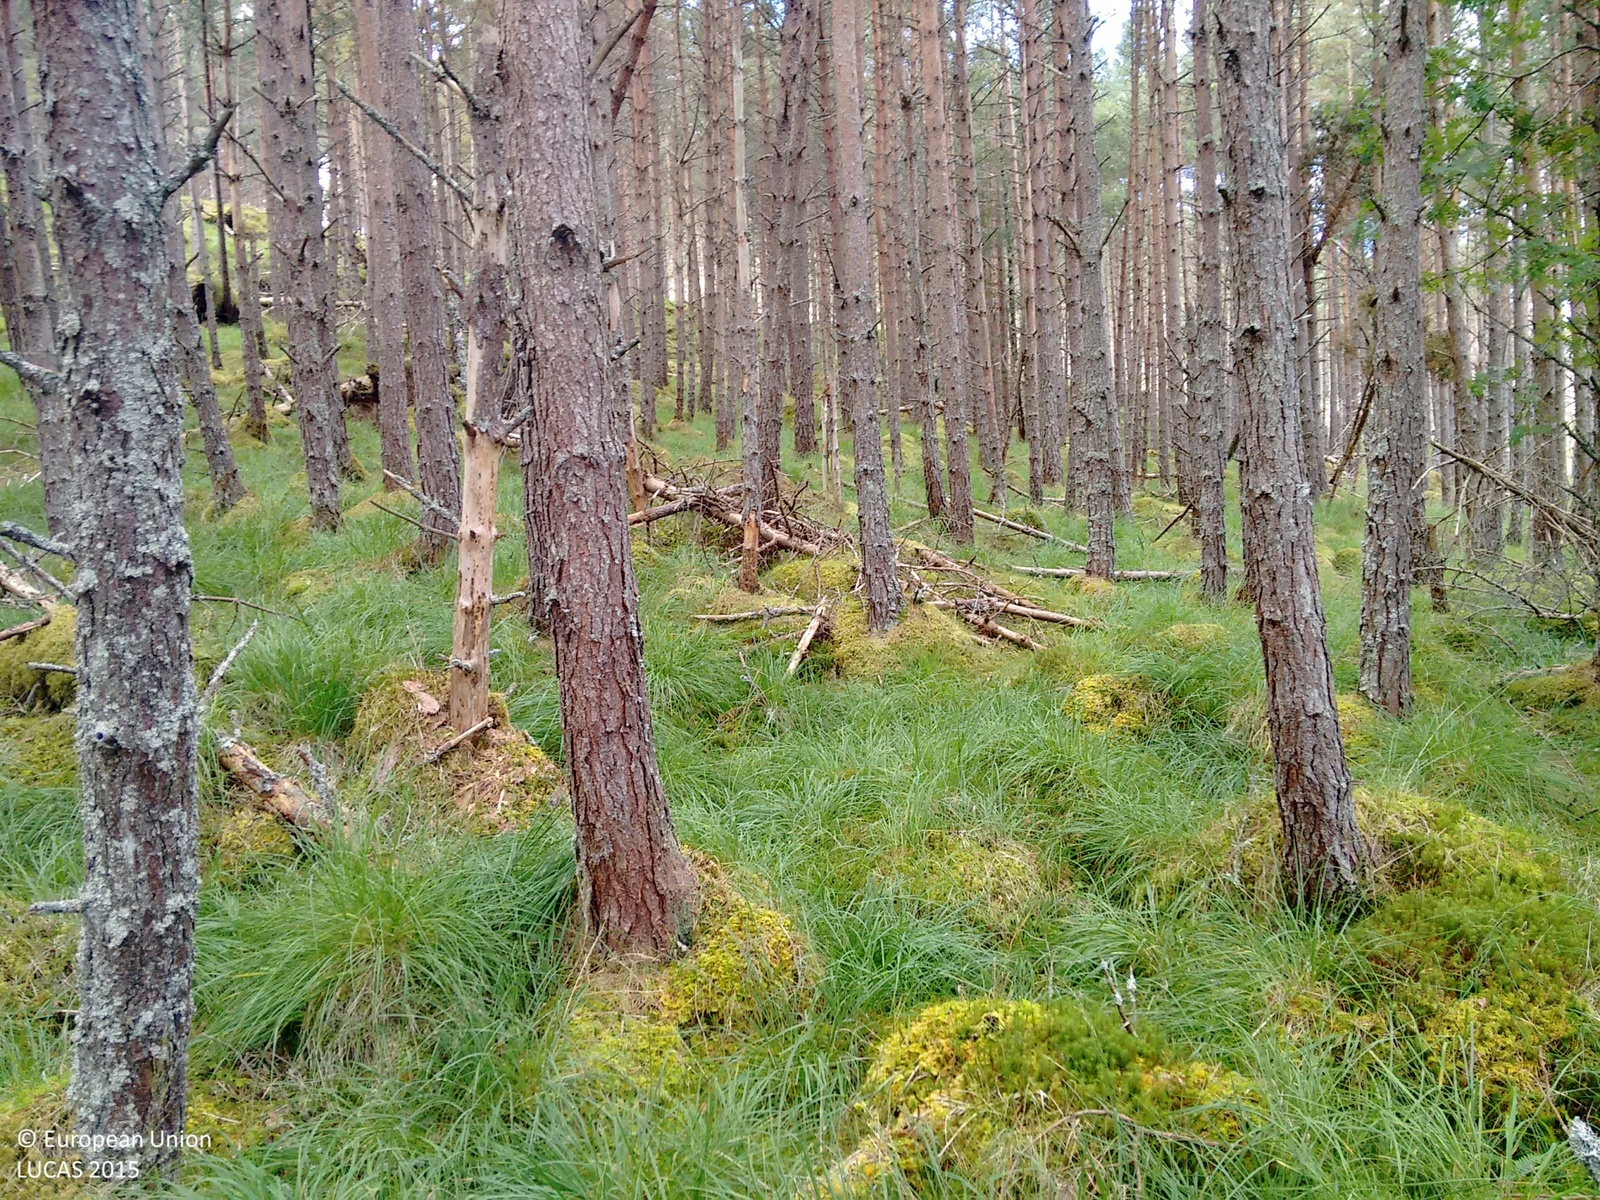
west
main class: Woodland
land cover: Pine dominated coniferous woodland
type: exotic forest
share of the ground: > 75 %
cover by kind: coniferous forest trees 100 %
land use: Forestry
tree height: > 5 m
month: September
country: GB
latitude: 57.5310
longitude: -4.8803
